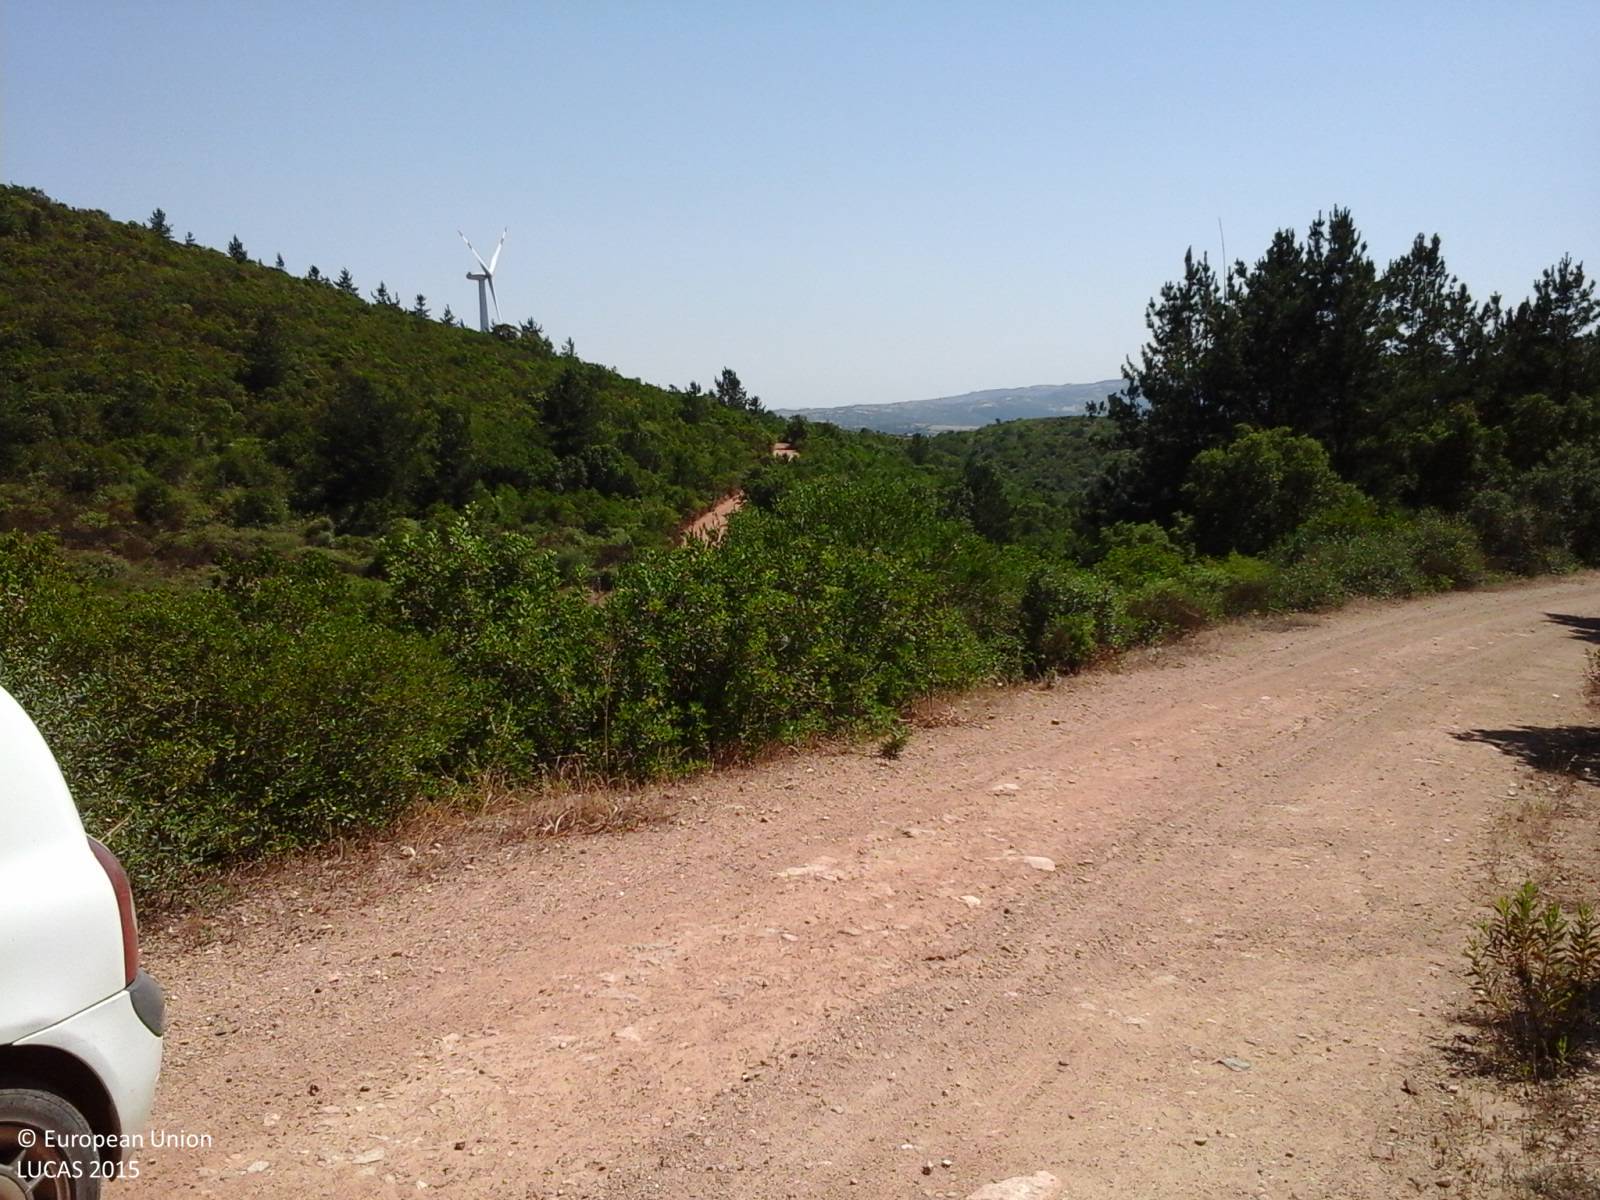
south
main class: Woodland
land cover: Broadleaved woodland
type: broadleaved evergreen forest
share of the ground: > 75 %
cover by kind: broadleaved forest trees 100 %
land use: Semi-natural and natural areas not in use
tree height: < 5 m
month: June
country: IT
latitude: 39.8984
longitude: 8.8485
